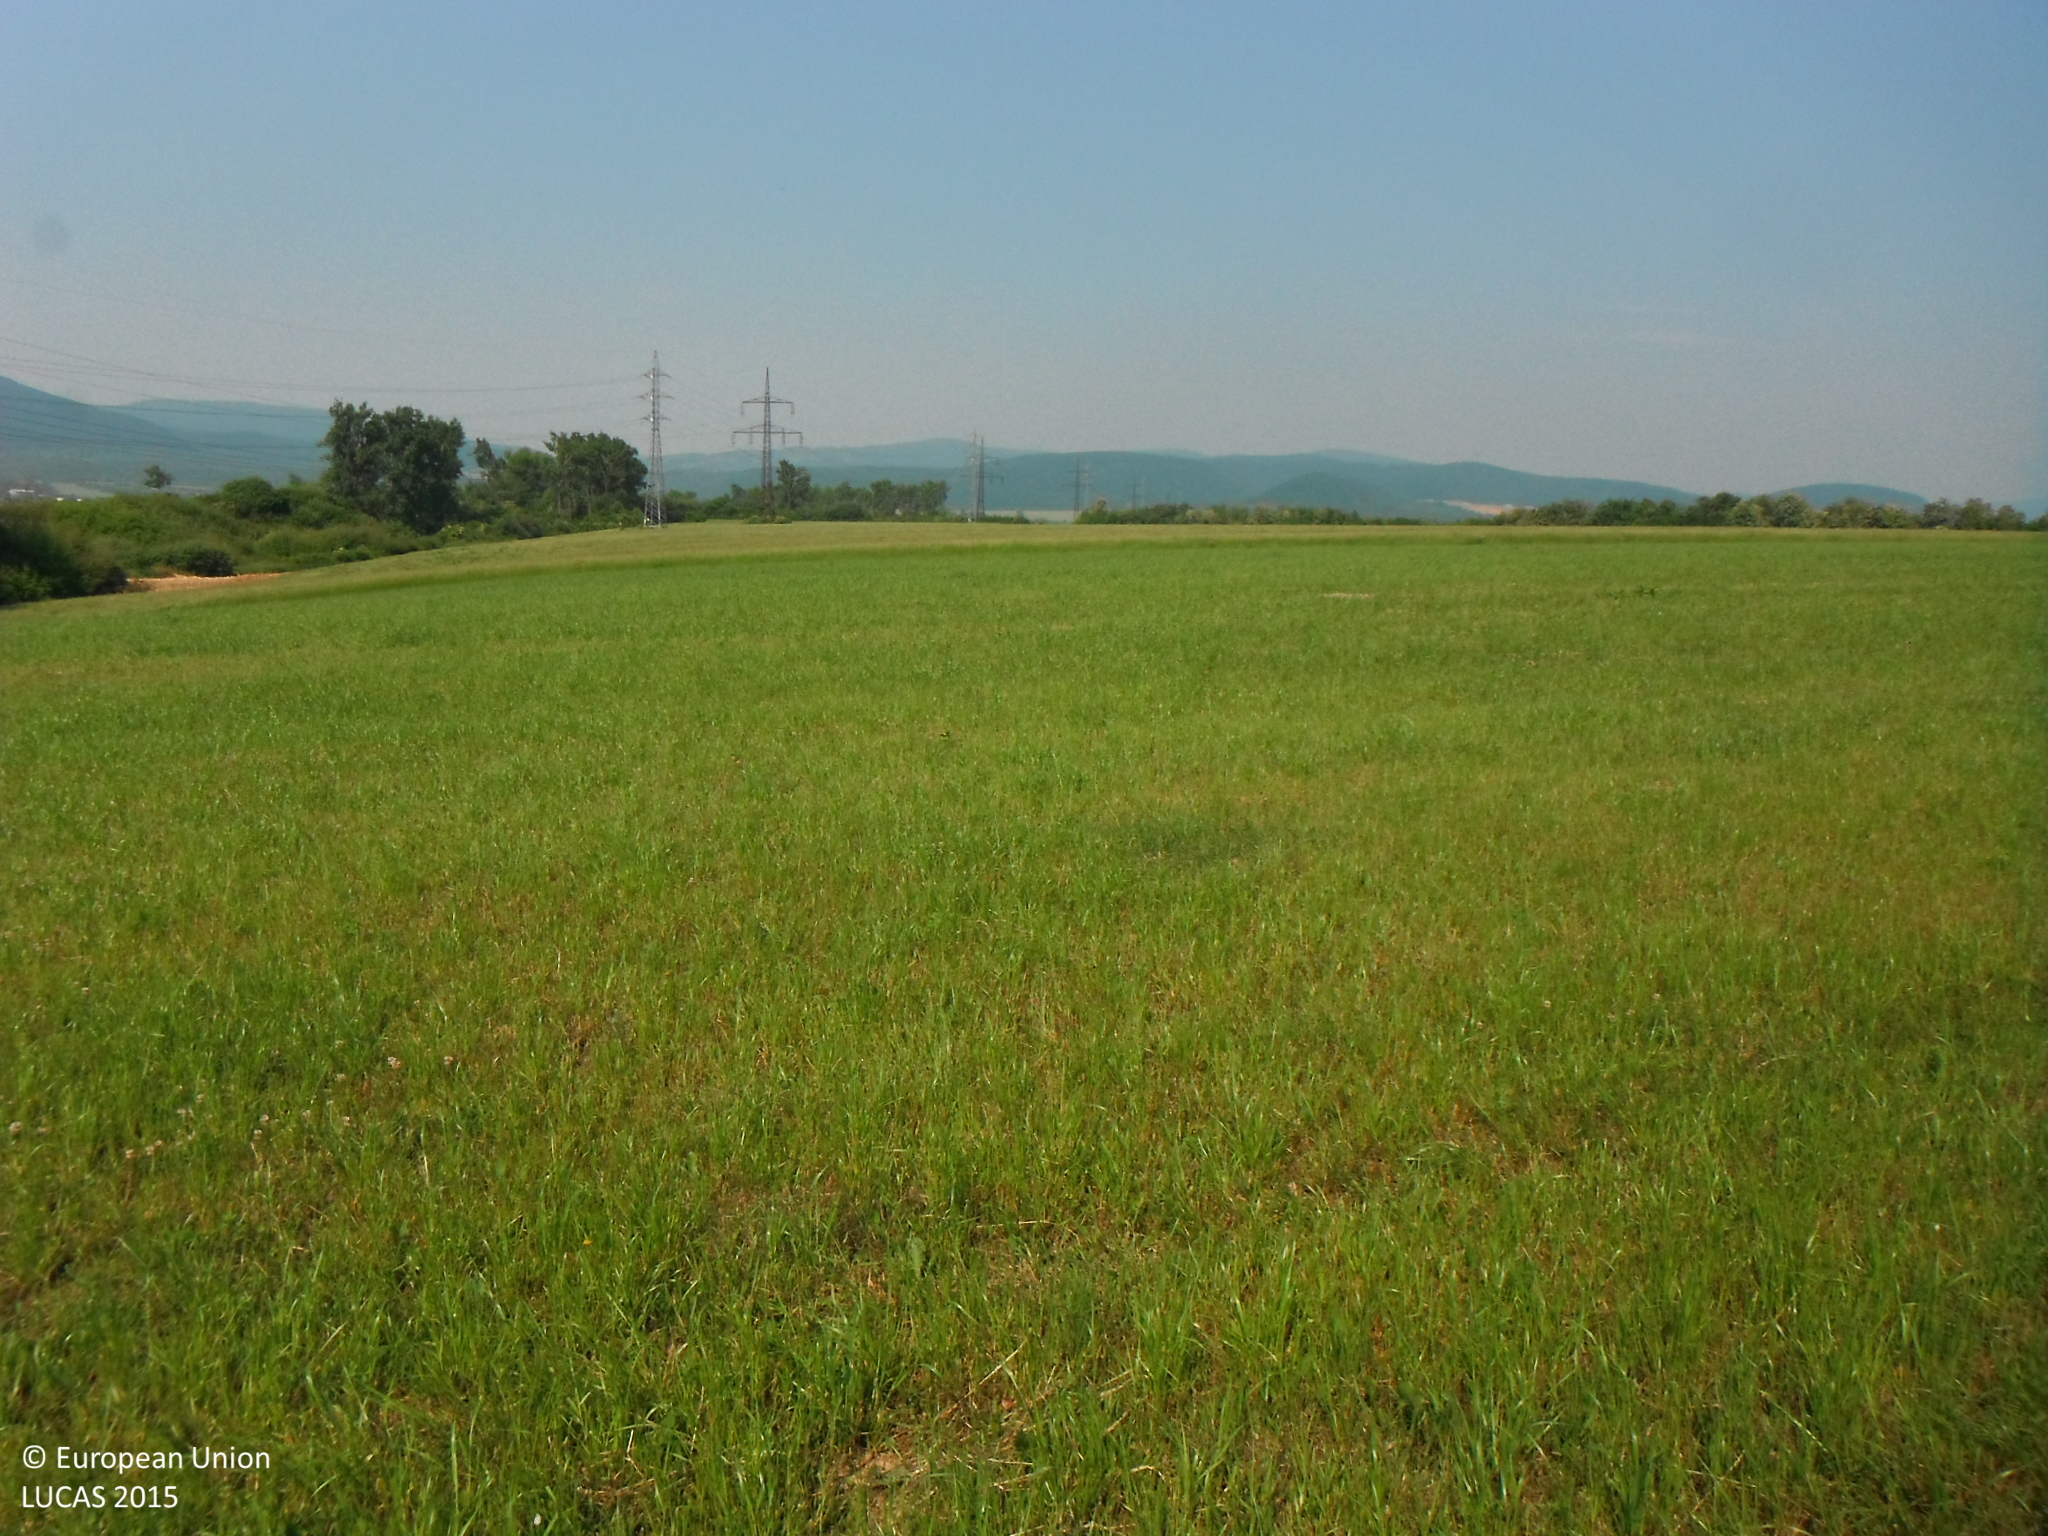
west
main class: Grassland
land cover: Grassland without tree/shrub cover
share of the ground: > 75 %
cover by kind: herbaceous plants 100 %
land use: Agriculture (excluding fallow land and kitchen gardens)
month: June
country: SK
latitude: 48.8372
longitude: 21.6720
